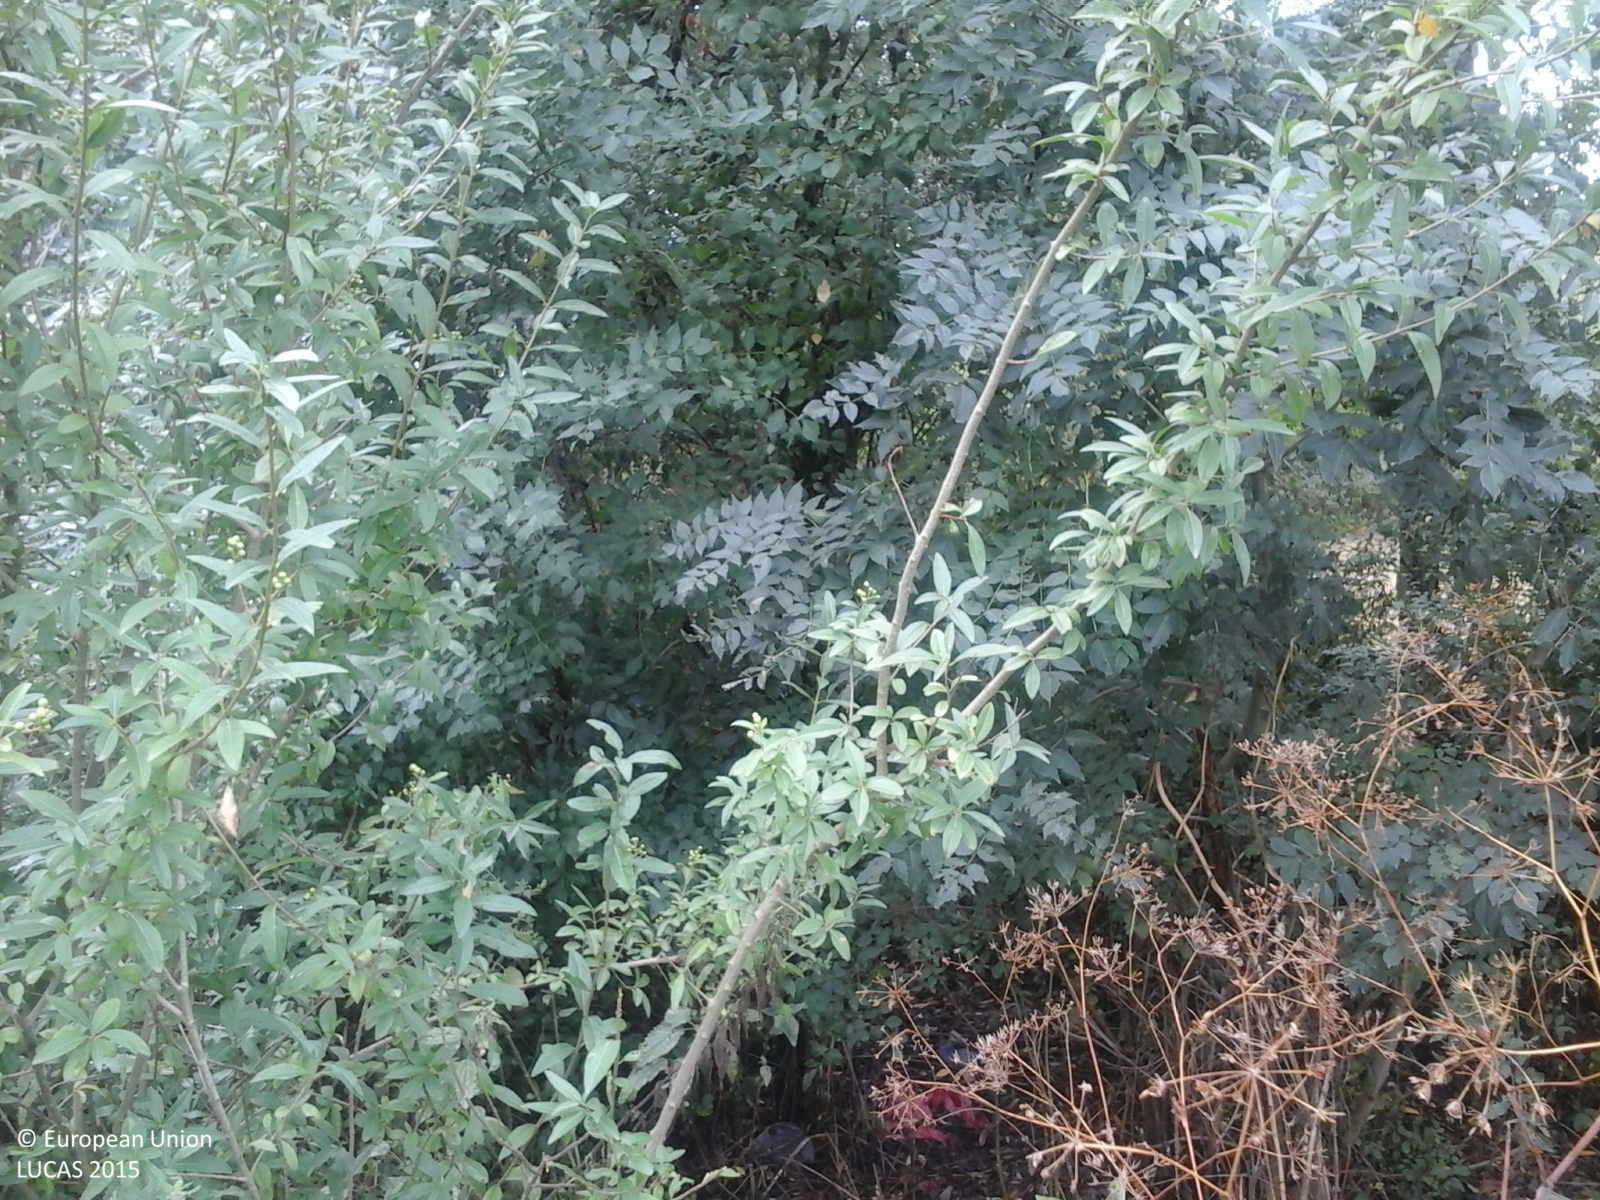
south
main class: Grassland
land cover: Spontaneously vegetated surfaces
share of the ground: > 75 %
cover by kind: herbaceous plants 100 %
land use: Fallow land
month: August
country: RO
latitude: 45.7110
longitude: 21.6608
